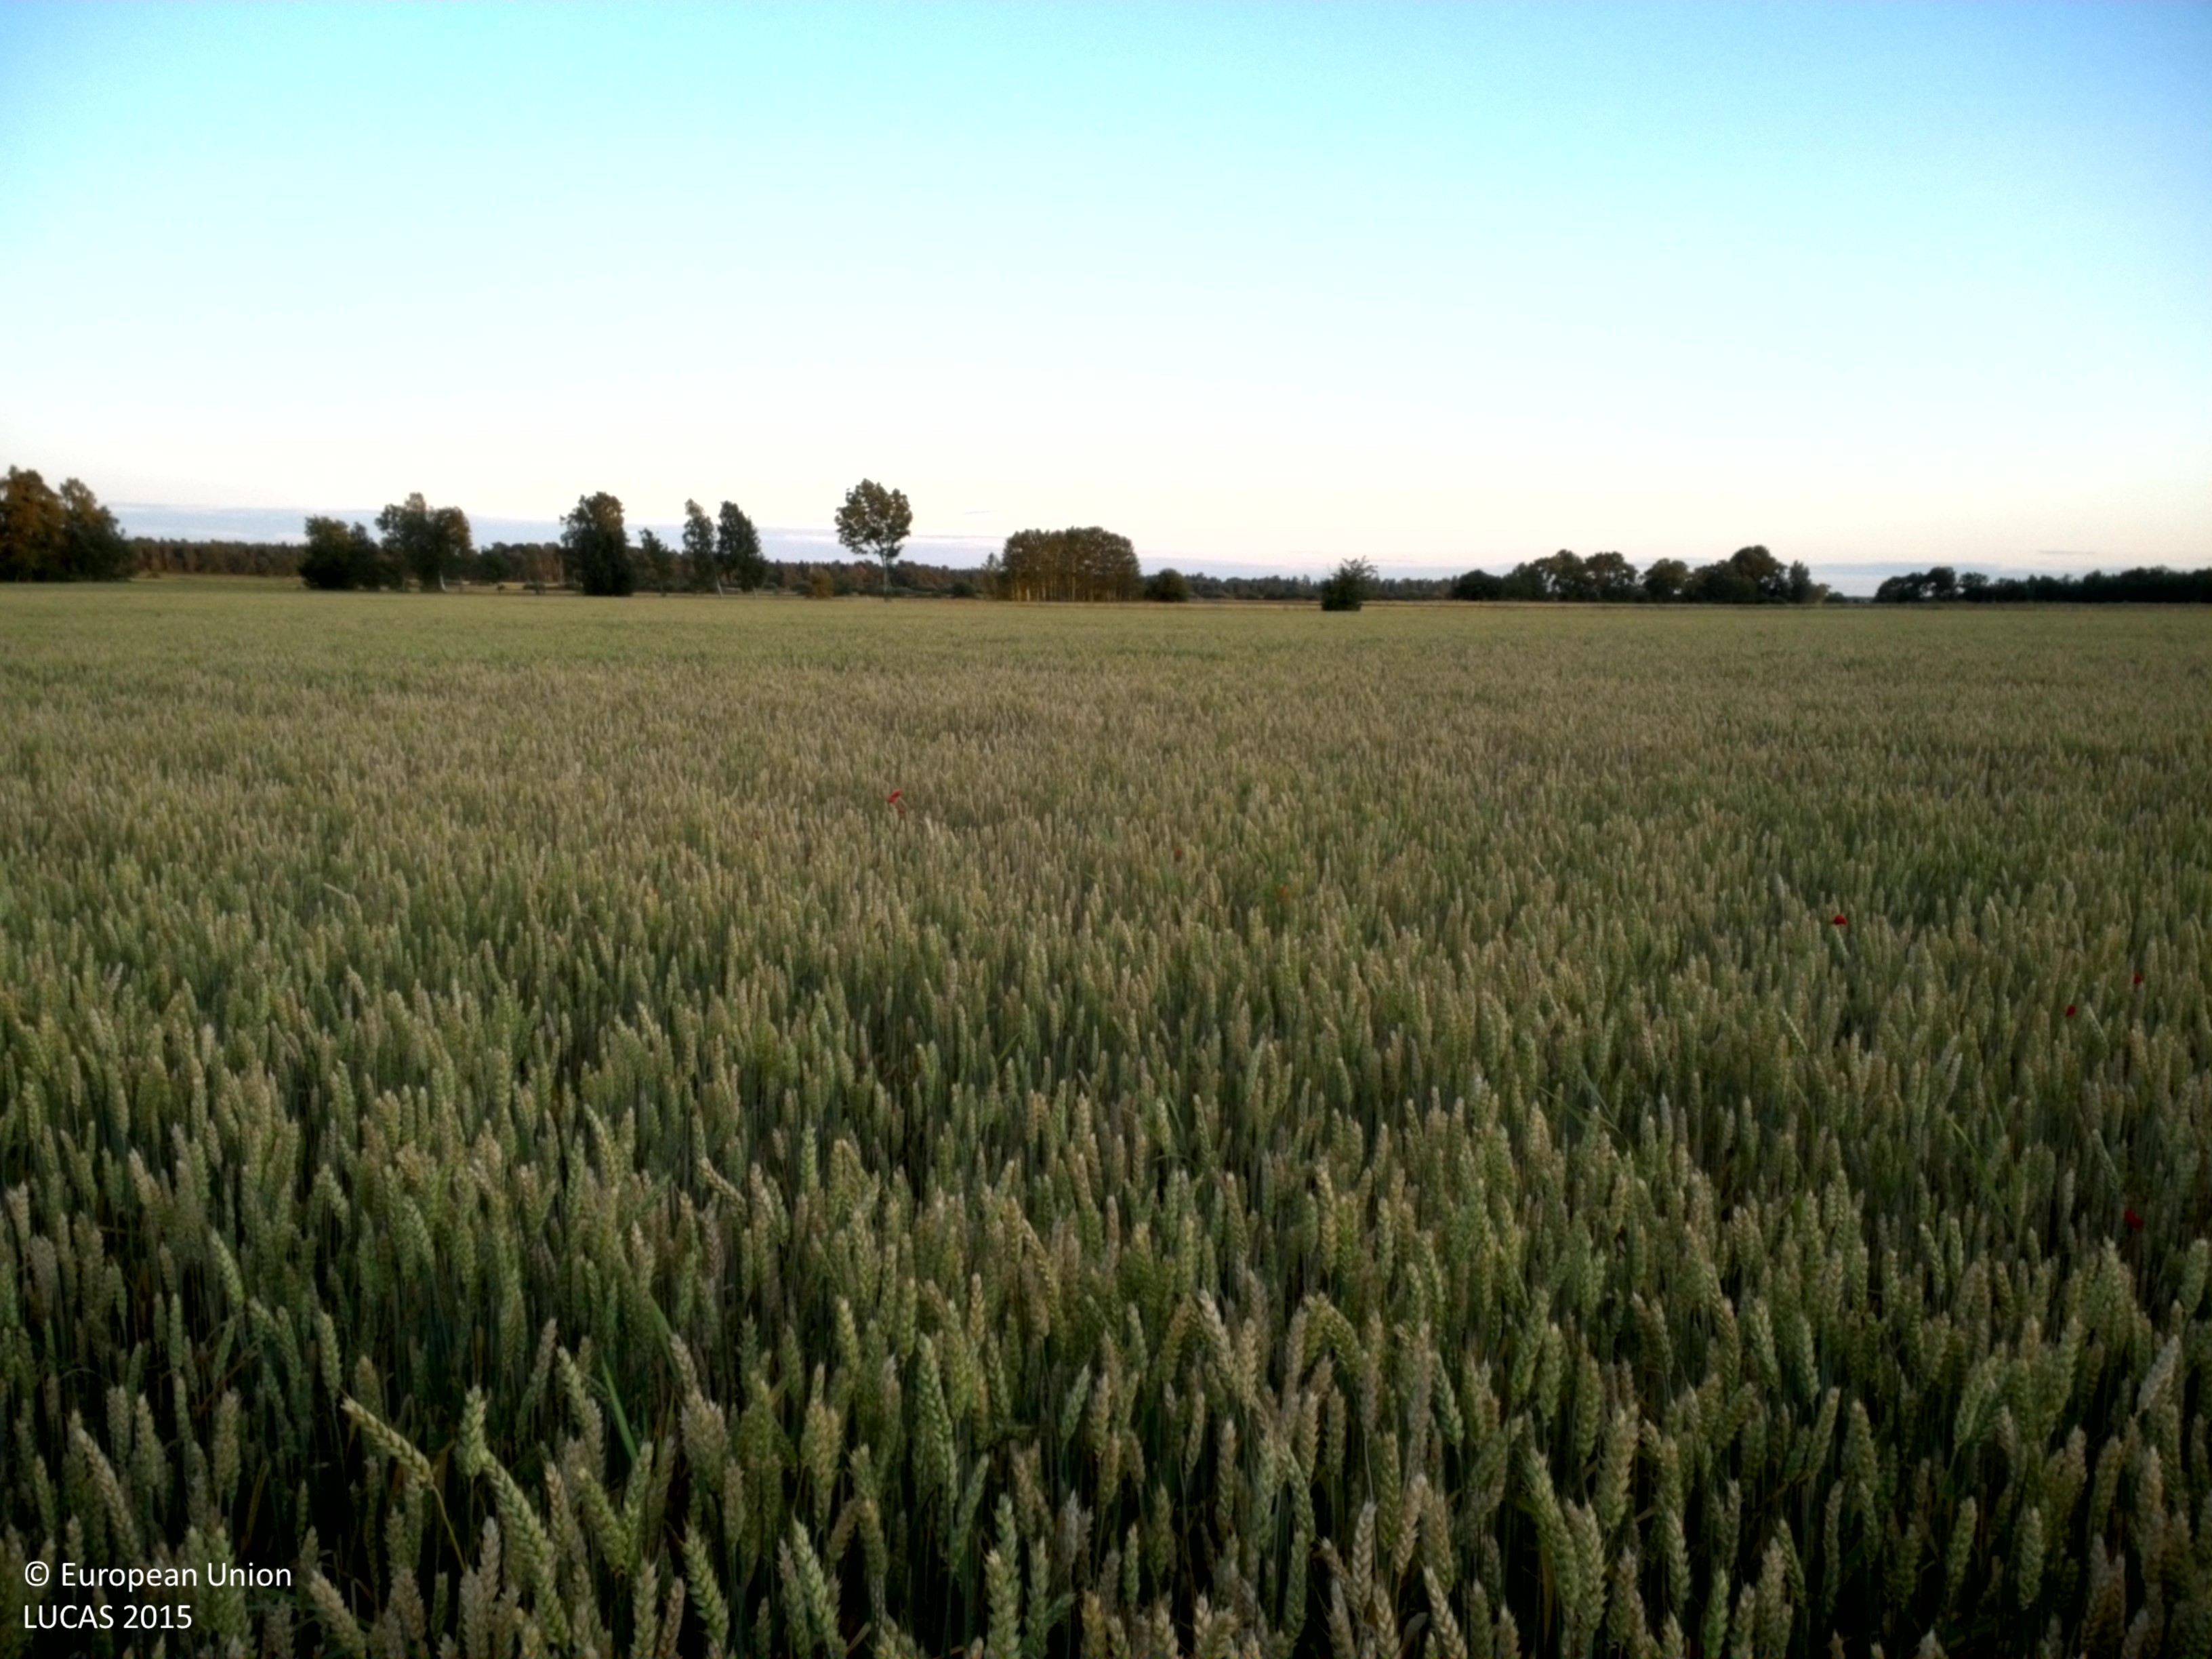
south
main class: Cropland
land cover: Common wheat
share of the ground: > 75 %
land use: Agriculture (excluding fallow land and kitchen gardens)
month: July
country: SE
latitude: 57.2835
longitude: 18.4529
